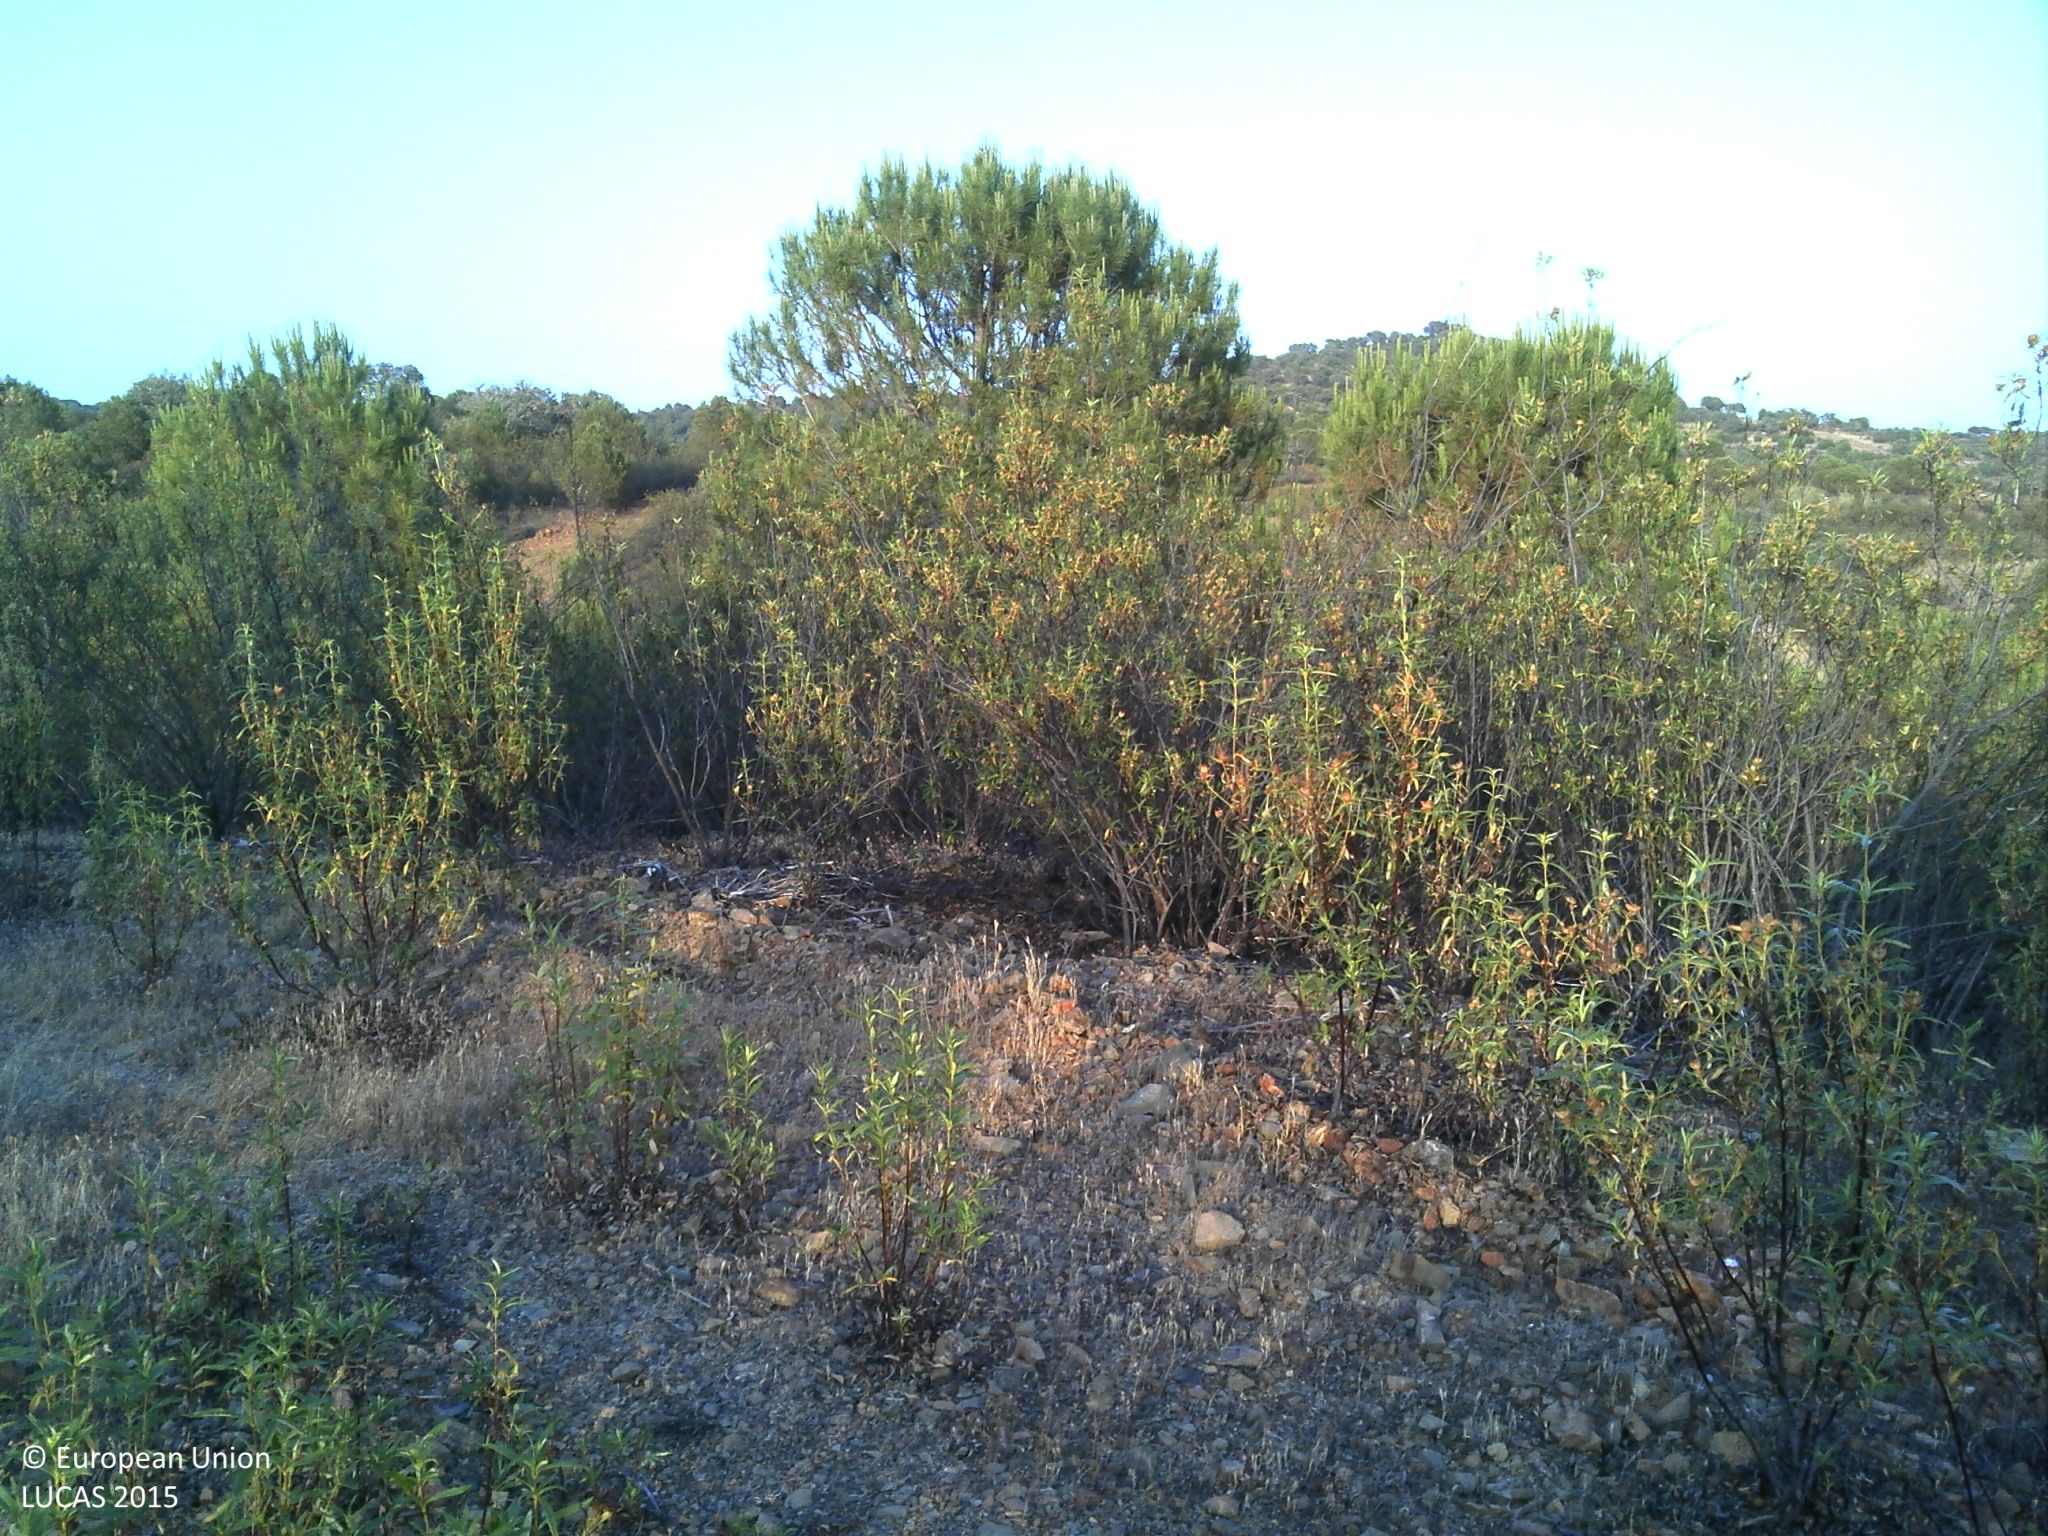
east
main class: Woodland
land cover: Pine dominated coniferous woodland
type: coniferous forest of the mediterranean region
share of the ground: 50 - 75 %
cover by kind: shrubs 65 %, coniferous forest trees 35 %
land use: Forestry
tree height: < 5 m
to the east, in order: Pine dominated coniferous woodland; Tracks; Pine dominated coniferous woodland; Shrubland without tree cover; Rivers and streams; Pine dominated coniferous woodland; Tracks; Pine dominated coniferous woodland; Grassland without tree/shrub cover; Rivers and streams; Single bushes/trees; Shrubland without tree cover; Electric lines; Grassland without tree/shrub cover; Paved roads, cycling and walking lanes; Grass margins; Electric lines; Shruby margins; Fences; Grassland with sparse tree/shrub cover; Pine dominated coniferous woodland; Electric lines; Pine dominated coniferous woodland
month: May
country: PT
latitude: 37.3982
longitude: -7.7360
